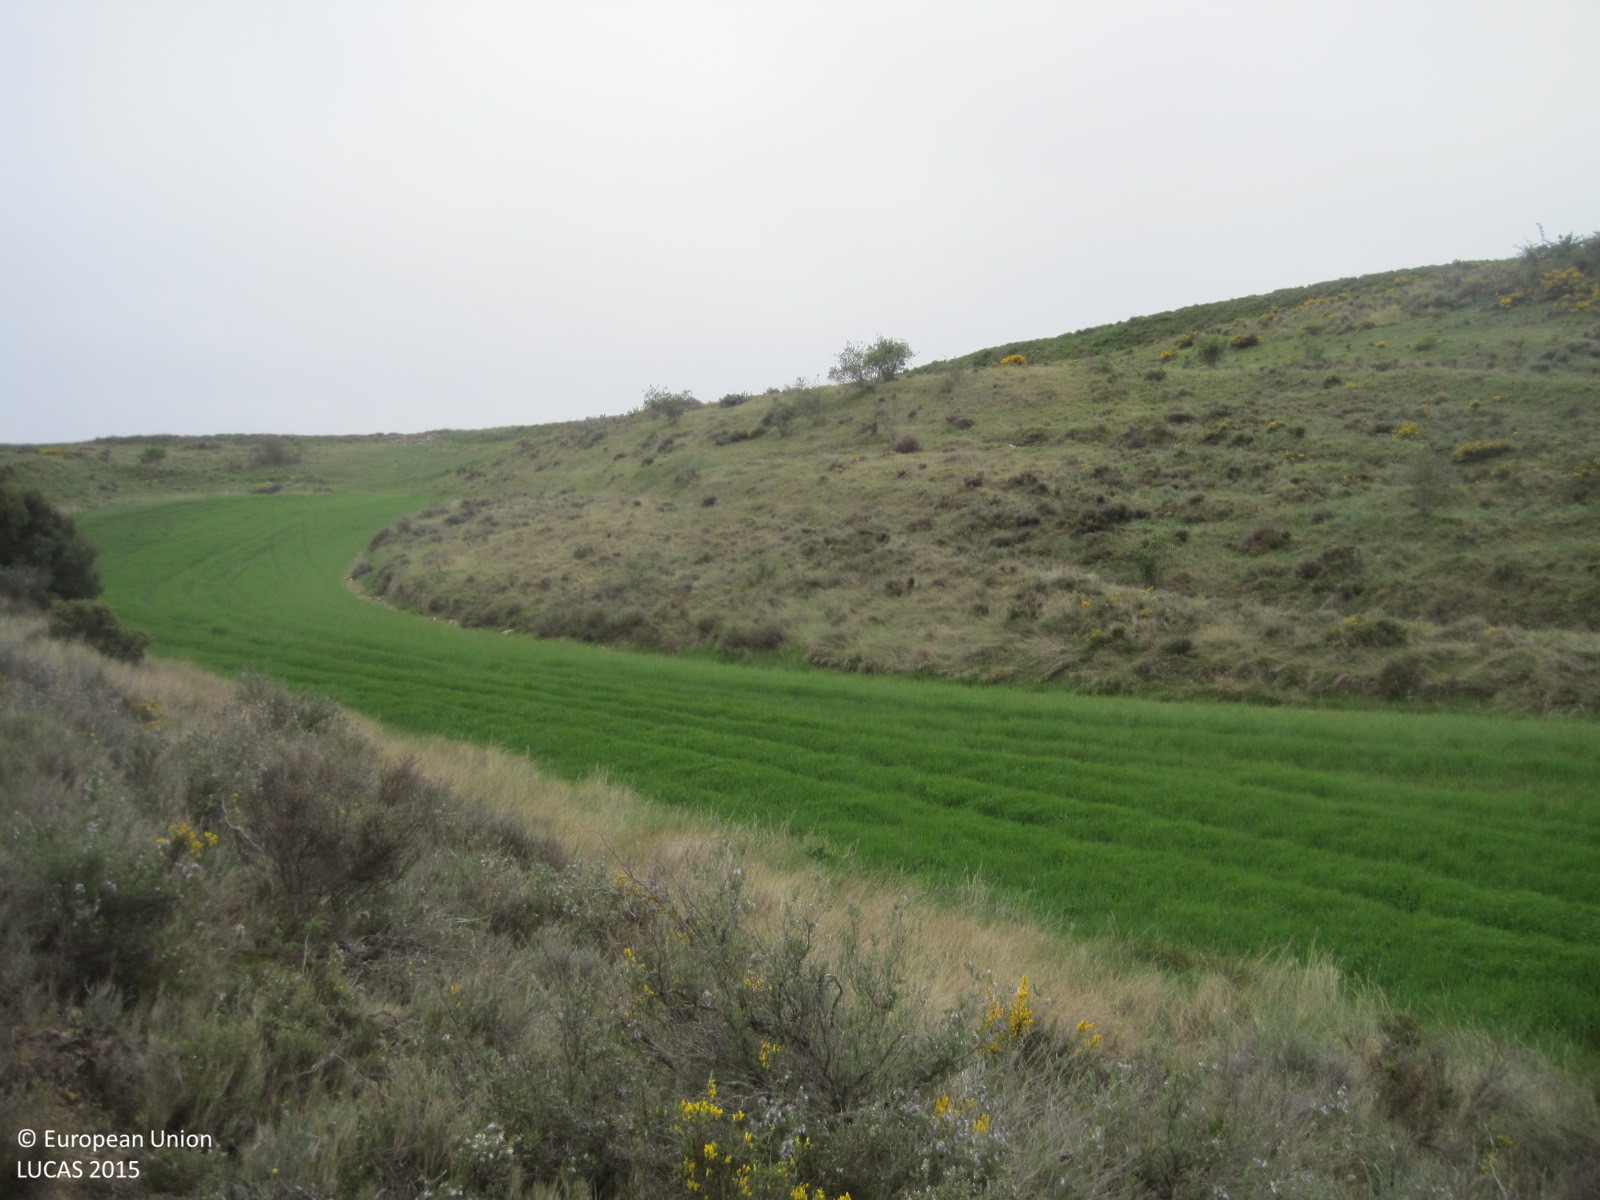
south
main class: Shrubland
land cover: Shrubland without tree cover
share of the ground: > 75 %
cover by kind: shrubs 60 %, unconsolidated bare surface 40 %
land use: Semi-natural and natural areas not in use
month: April
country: ES
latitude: 42.5183
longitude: -2.1777
